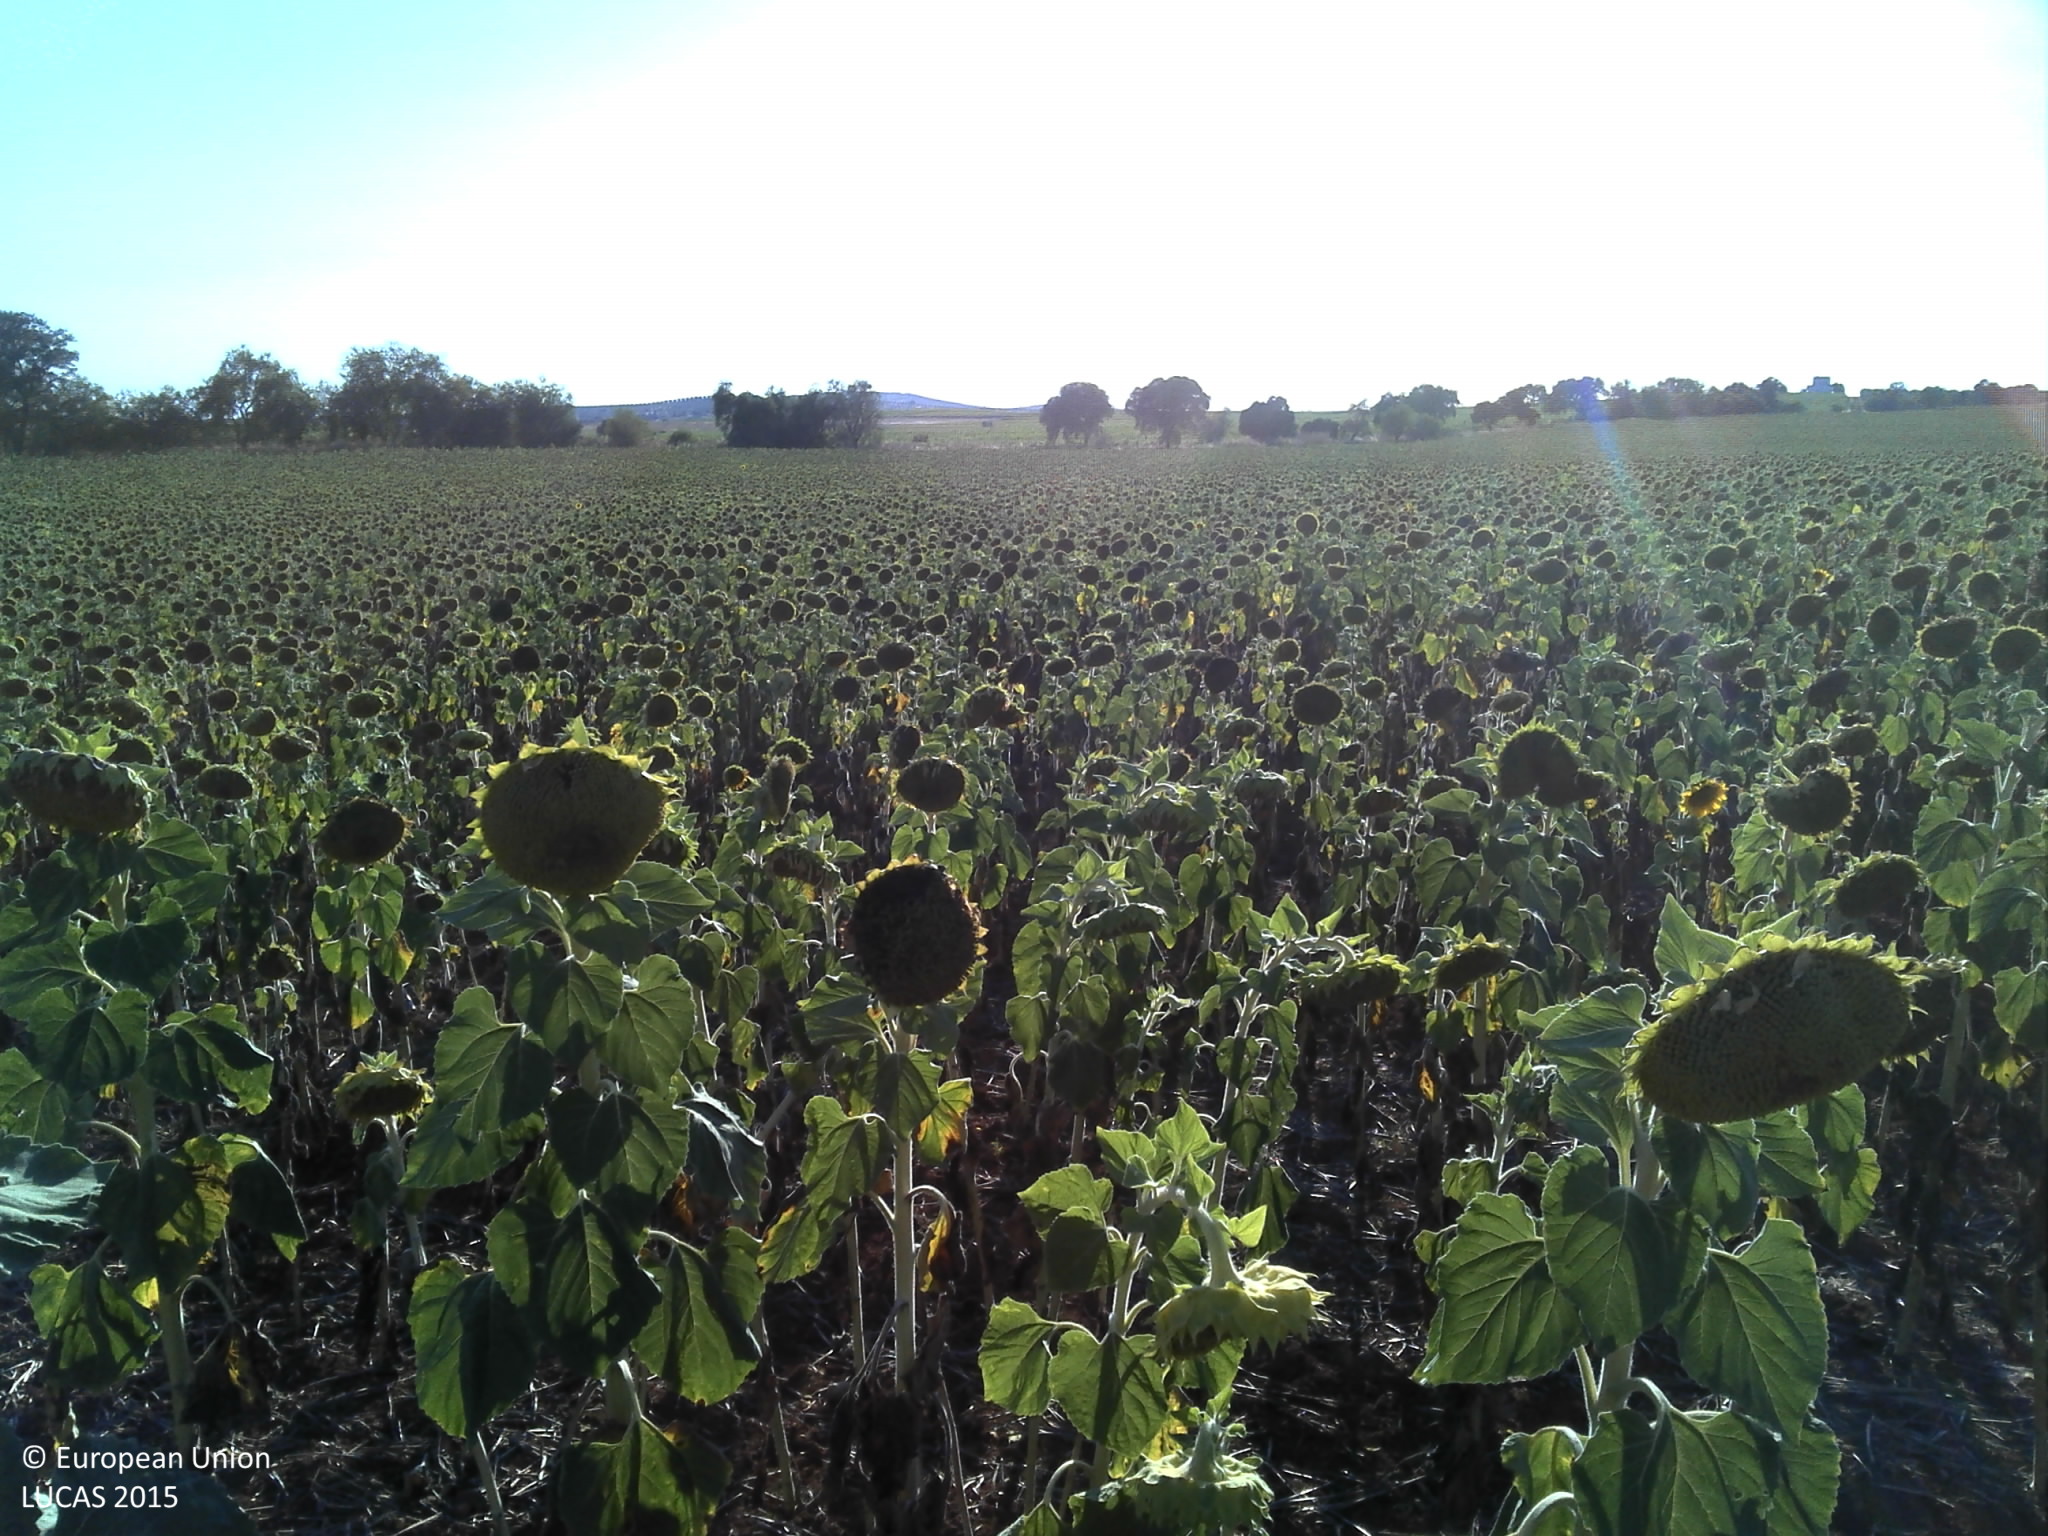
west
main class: Cropland
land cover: Sunflower
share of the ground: > 75 %
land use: Agriculture (excluding fallow land and kitchen gardens)
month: July
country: PT
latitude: 38.0925
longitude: -7.3841
